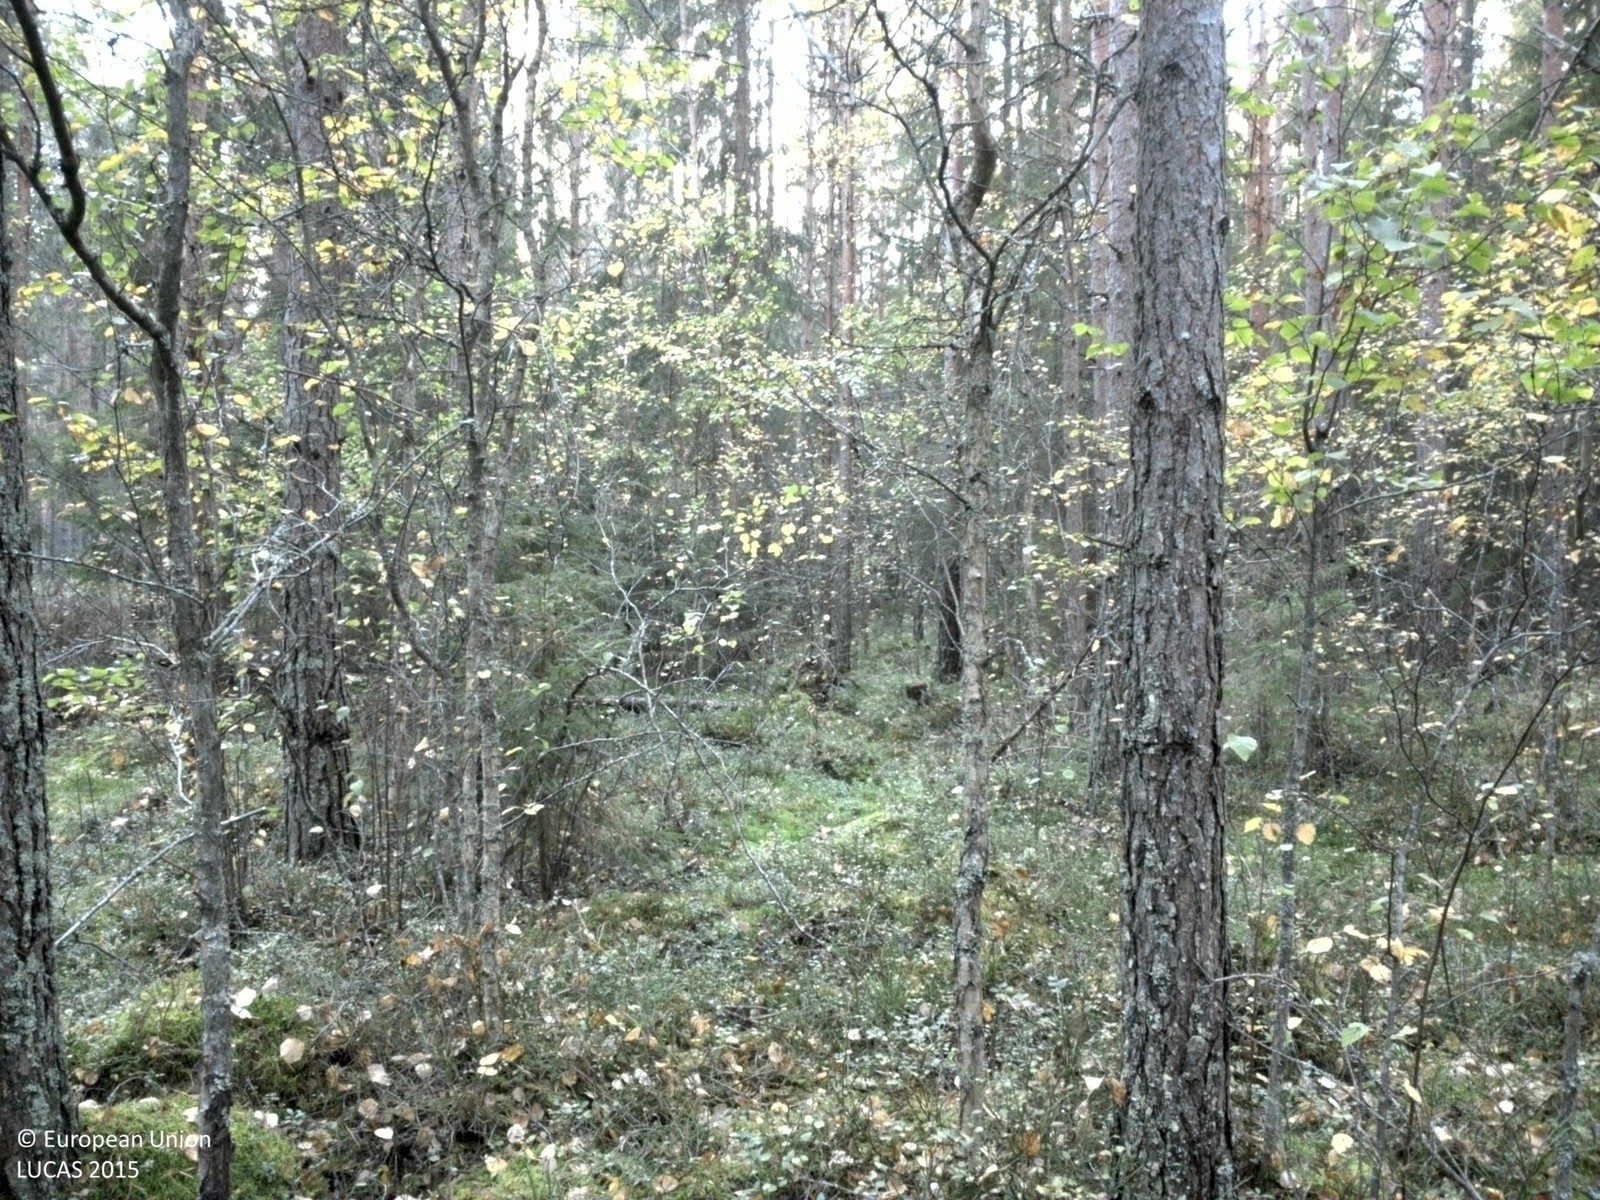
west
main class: Woodland
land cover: Pine dominated coniferous woodland
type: boreal forest
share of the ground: > 75 %
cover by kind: coniferous forest trees 70 %, broadleaved forest trees 15 %, lichens and mosses 15 %
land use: Forestry
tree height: > 5 m
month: September
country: SE
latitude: 59.9931
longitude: 16.5338
